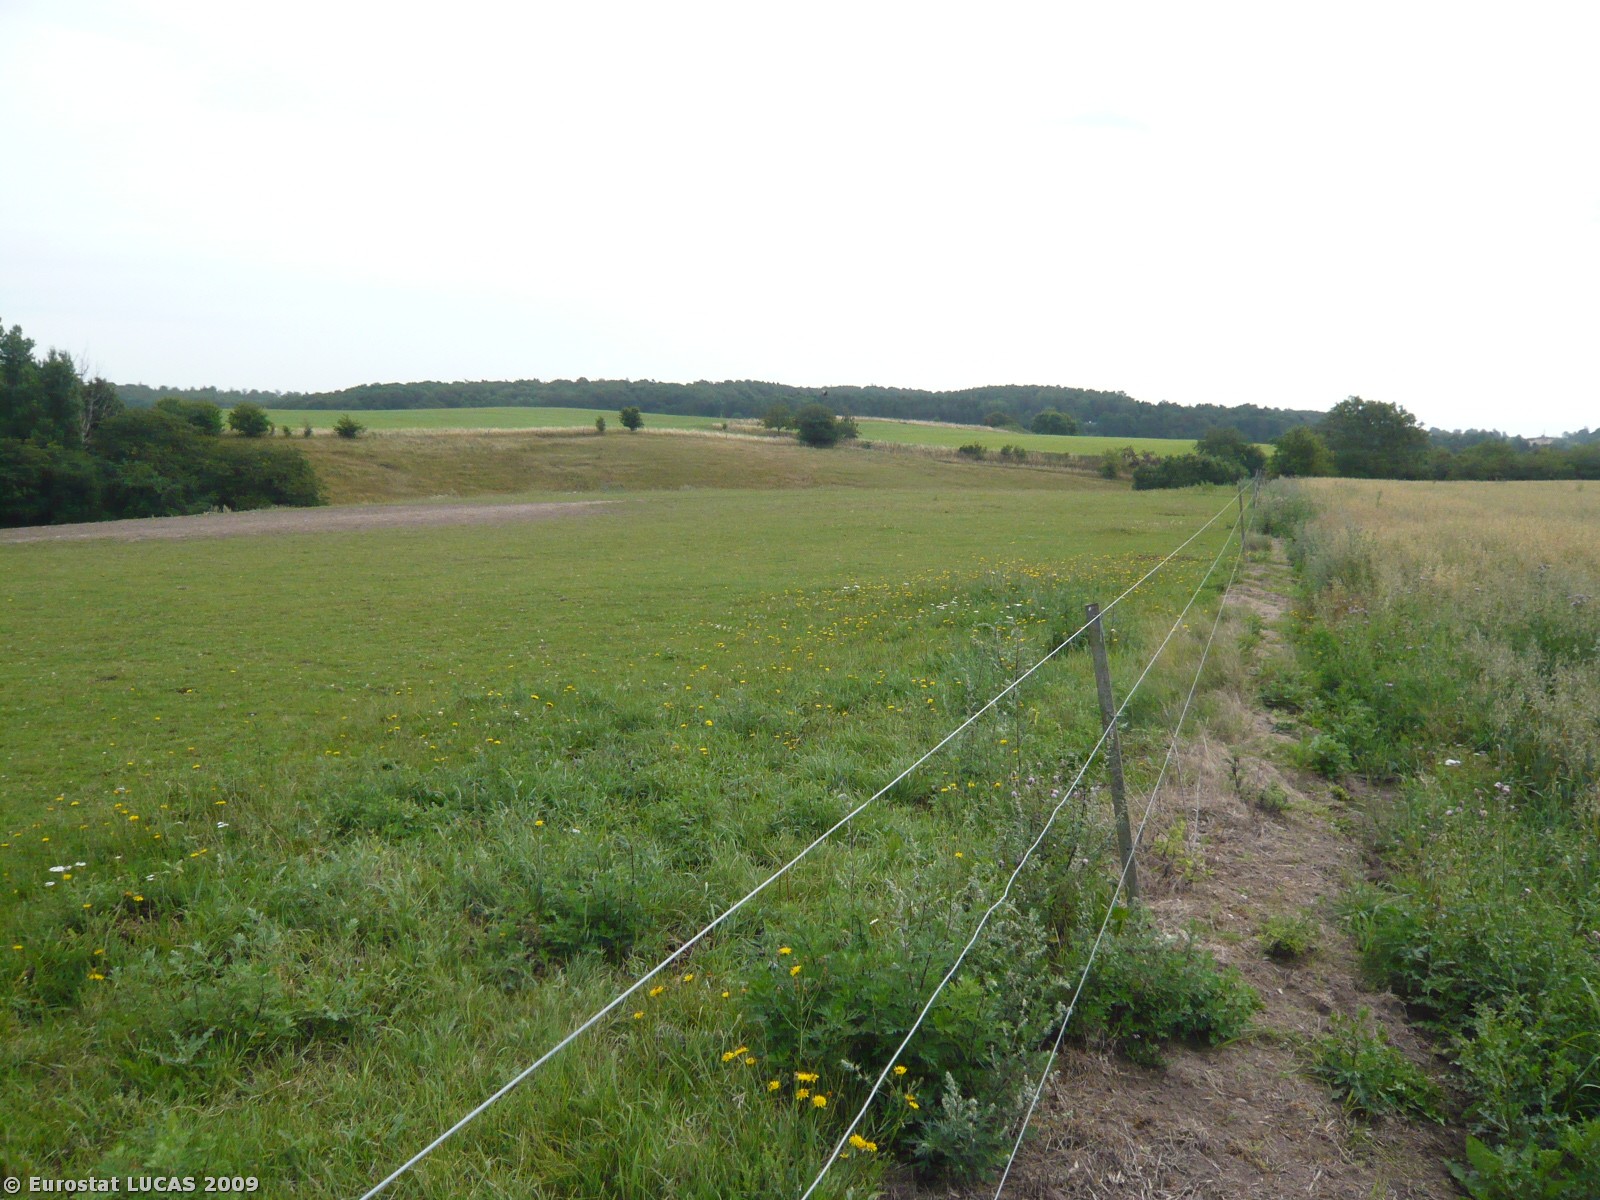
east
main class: Grassland
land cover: Grassland without tree/shrub cover
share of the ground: > 75 %
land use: Agriculture (excluding fallow land and kitchen gardens)
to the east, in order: Grassland without tree/shrub cover; Fences; Grassland with sparse tree/shrub cover; Fences; Grass margins; Grassland without tree/shrub cover; Grass margins; Grassland without tree/shrub cover; Grass margins; Grassland without tree/shrub cover
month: July
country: DK
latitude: 55.8095
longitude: 12.1841
